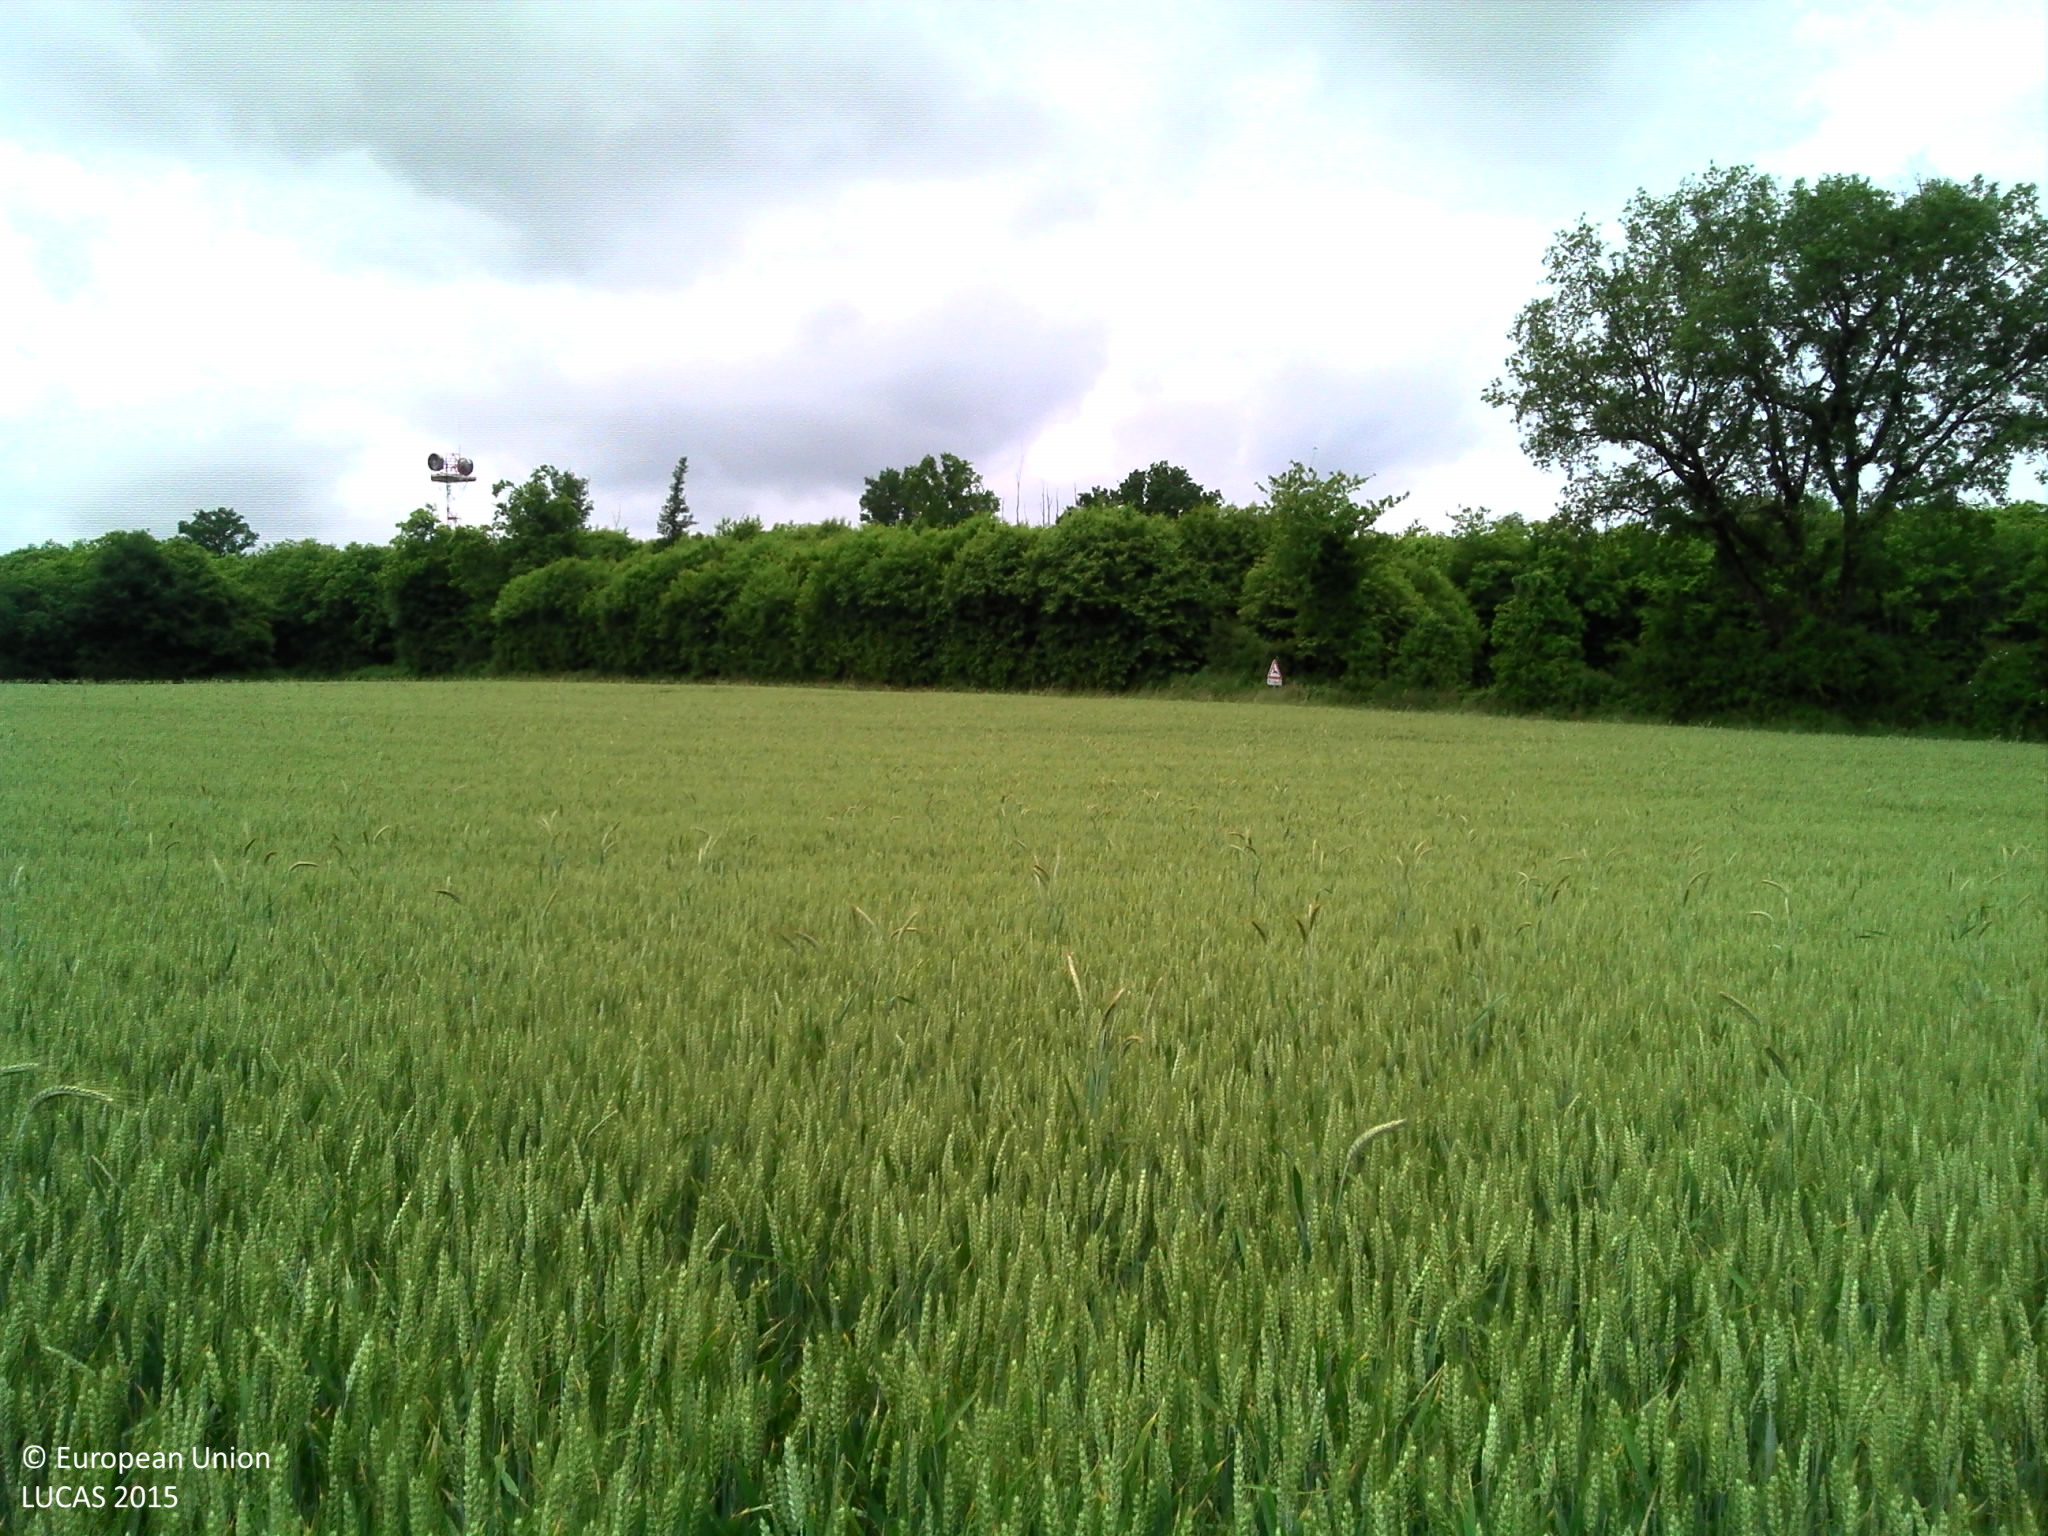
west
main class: Cropland
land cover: Common wheat
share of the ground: > 75 %
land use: Agriculture (excluding fallow land and kitchen gardens)
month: June
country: FR
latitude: 46.0058
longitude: 0.3628
